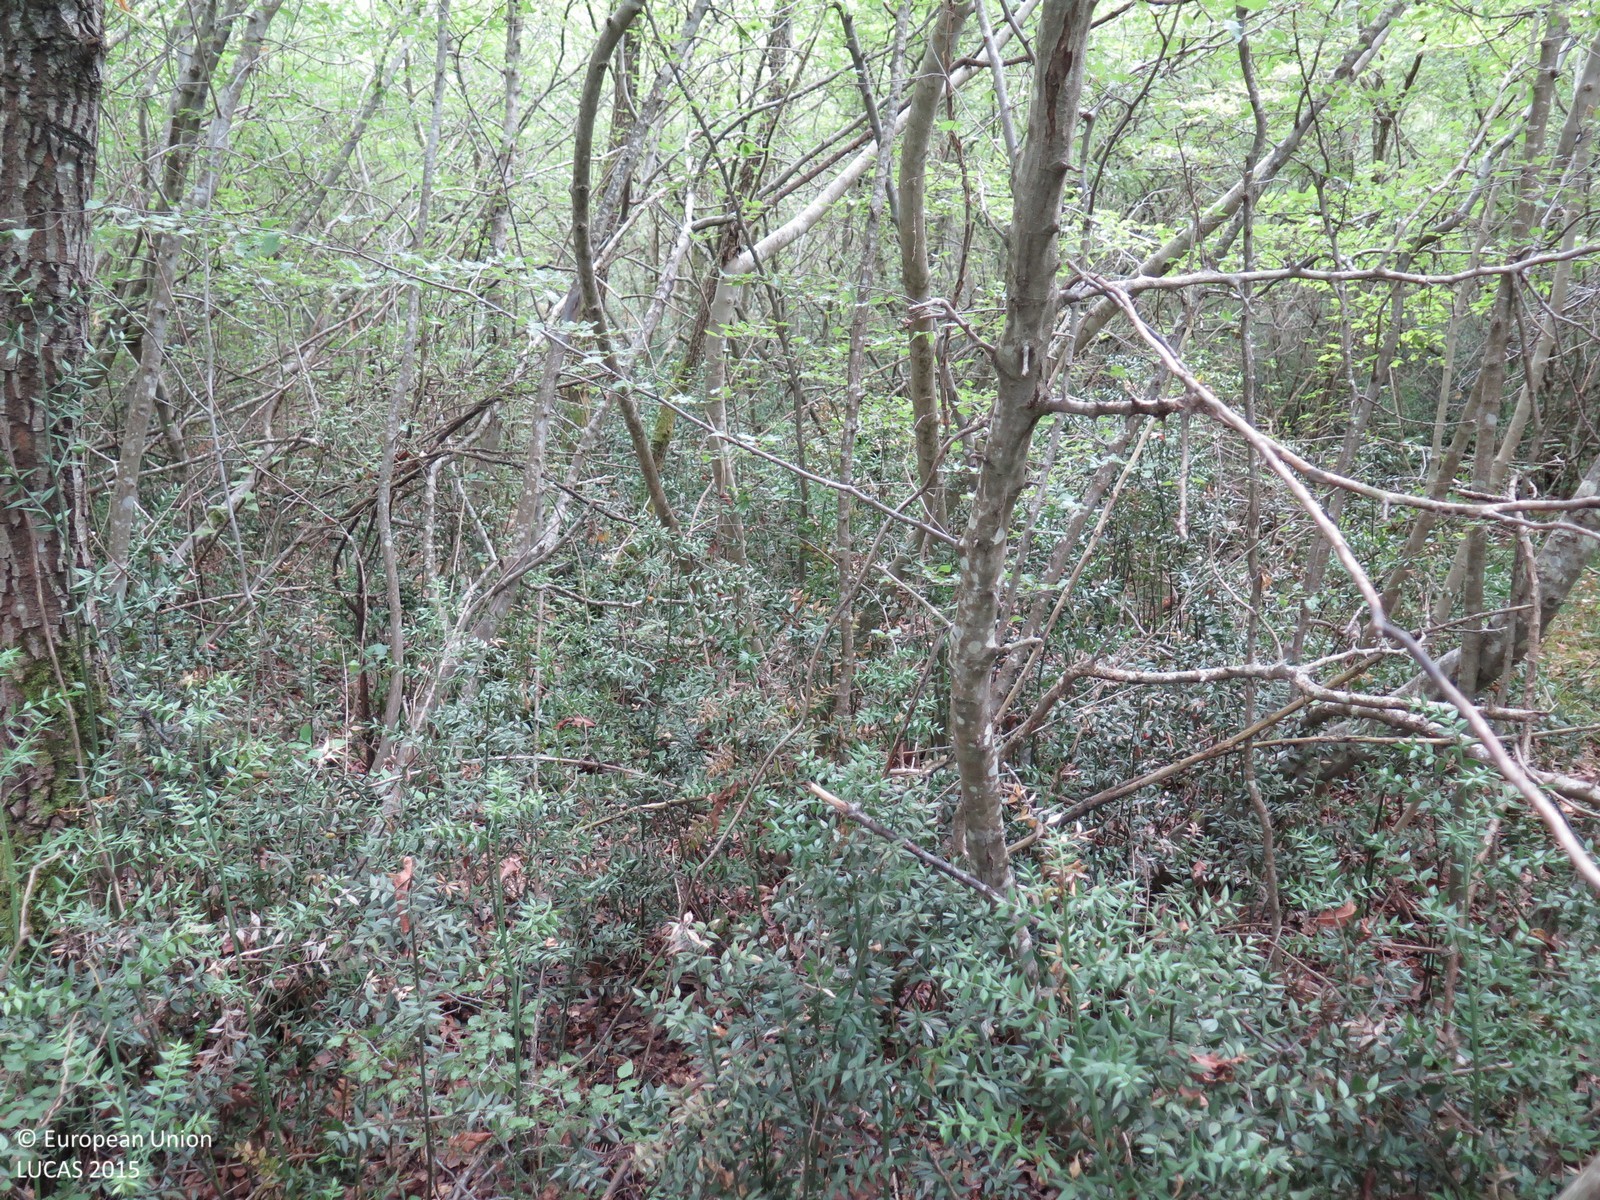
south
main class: Woodland
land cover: Broadleaved woodland
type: beech forest
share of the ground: > 75 %
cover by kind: broadleaved forest trees 95 %, shrubs 5 %
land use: Semi-natural and natural areas not in use
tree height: > 5 m
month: June
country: HR
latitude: 45.2428
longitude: 13.6512
